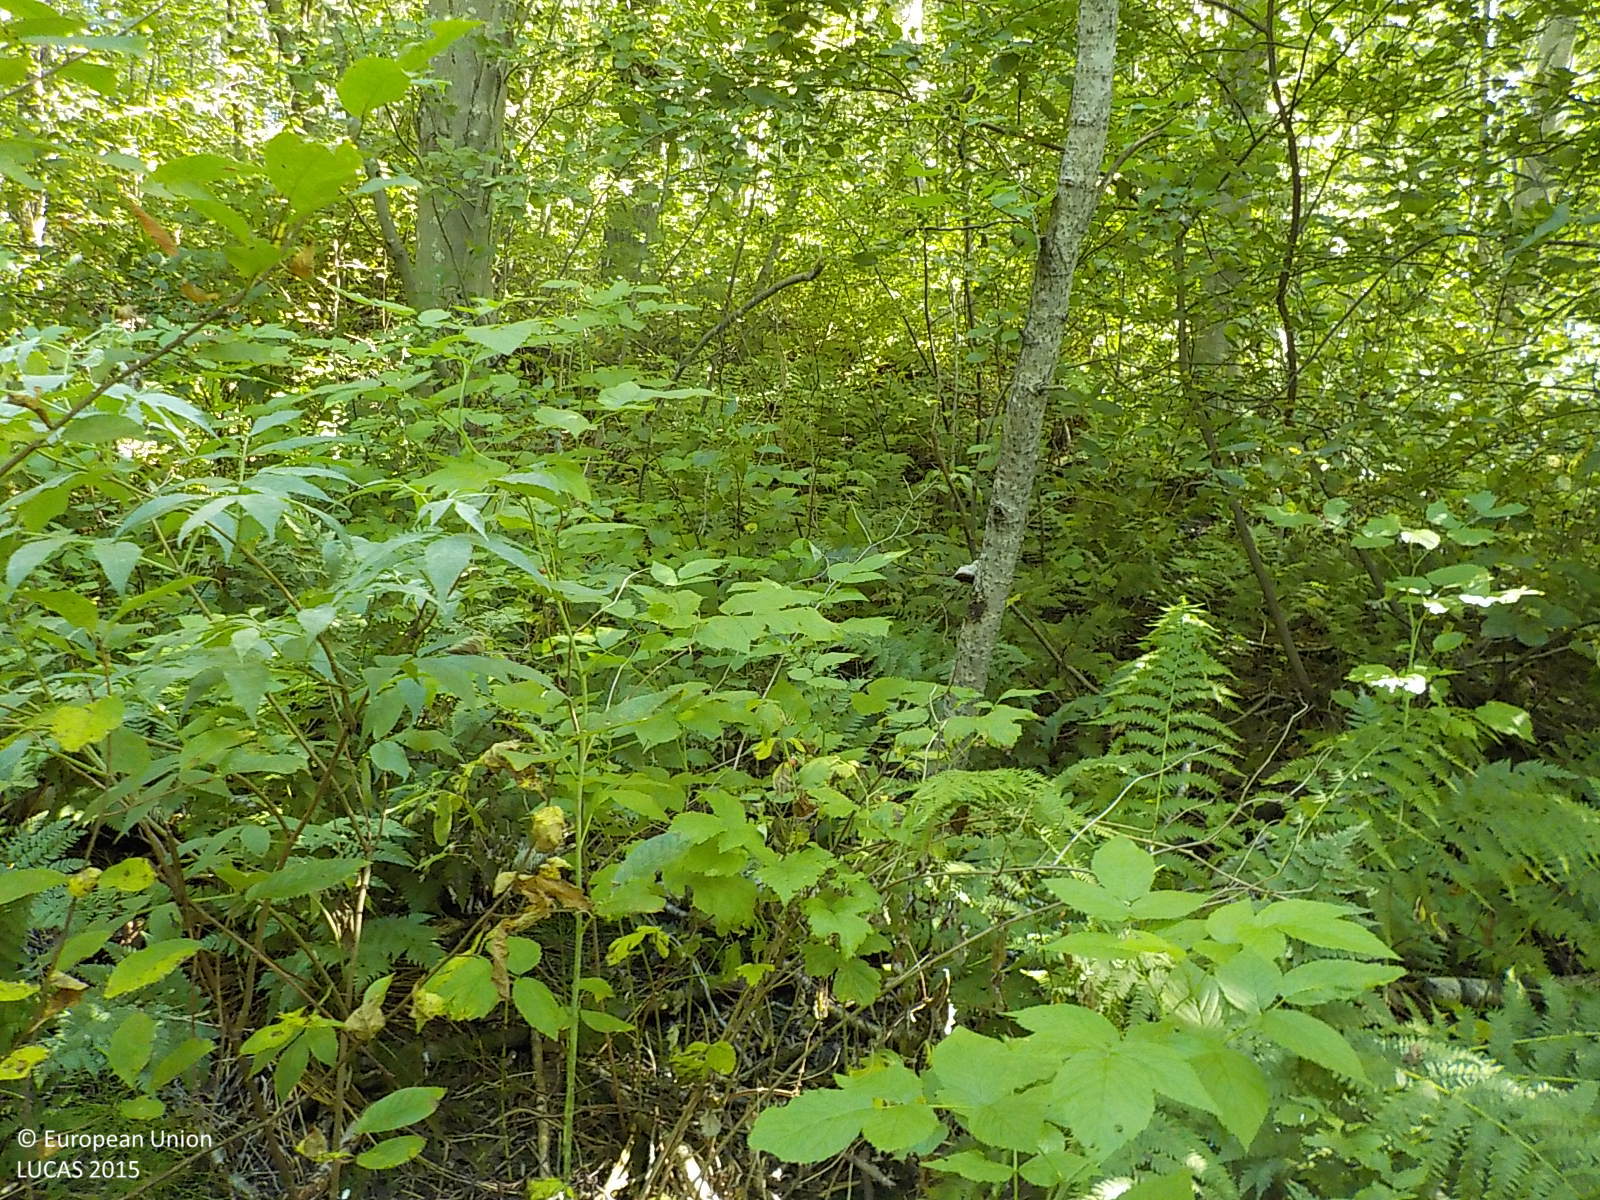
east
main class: Woodland
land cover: Broadleaved woodland
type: hemiboreal forest and nemoral coniferous forest and mixed broadleaved-coniferous forest
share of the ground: > 75 %
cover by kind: broadleaved forest trees 95 %, herbaceous plants 5 %
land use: Forestry
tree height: > 5 m
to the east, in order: Broadleaved woodland; Grass margins; Paved roads, cycling and walking lanes; Grass margins; Broadleaved woodland; Spruce dominated mixed woodland; Tracks; Spruce dominated mixed woodland; Tracks; Spruce dominated mixed woodland
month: August
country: SE
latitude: 63.3251
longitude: 18.6630
